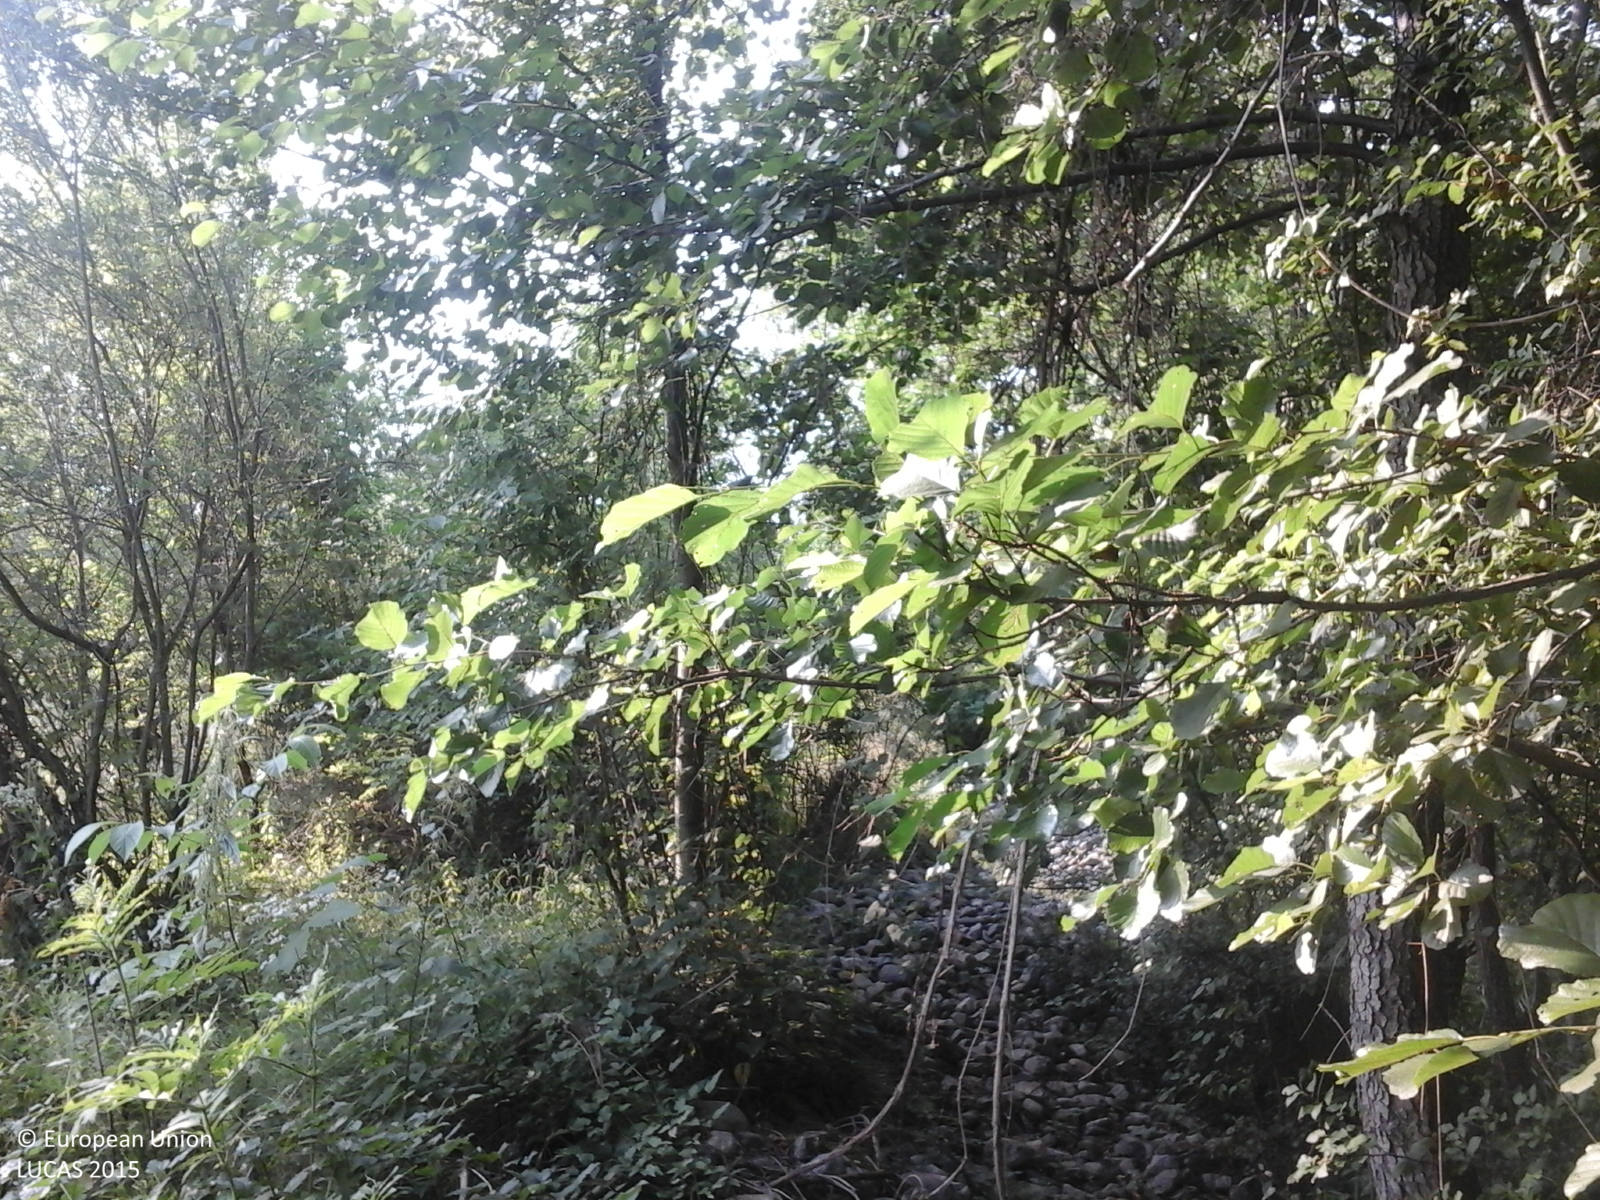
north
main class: Woodland
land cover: Broadleaved woodland
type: beech forest
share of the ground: > 75 %
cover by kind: broadleaved forest trees 100 %
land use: Forestry
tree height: > 5 m
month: July
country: RO
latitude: 45.0937
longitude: 24.5500
